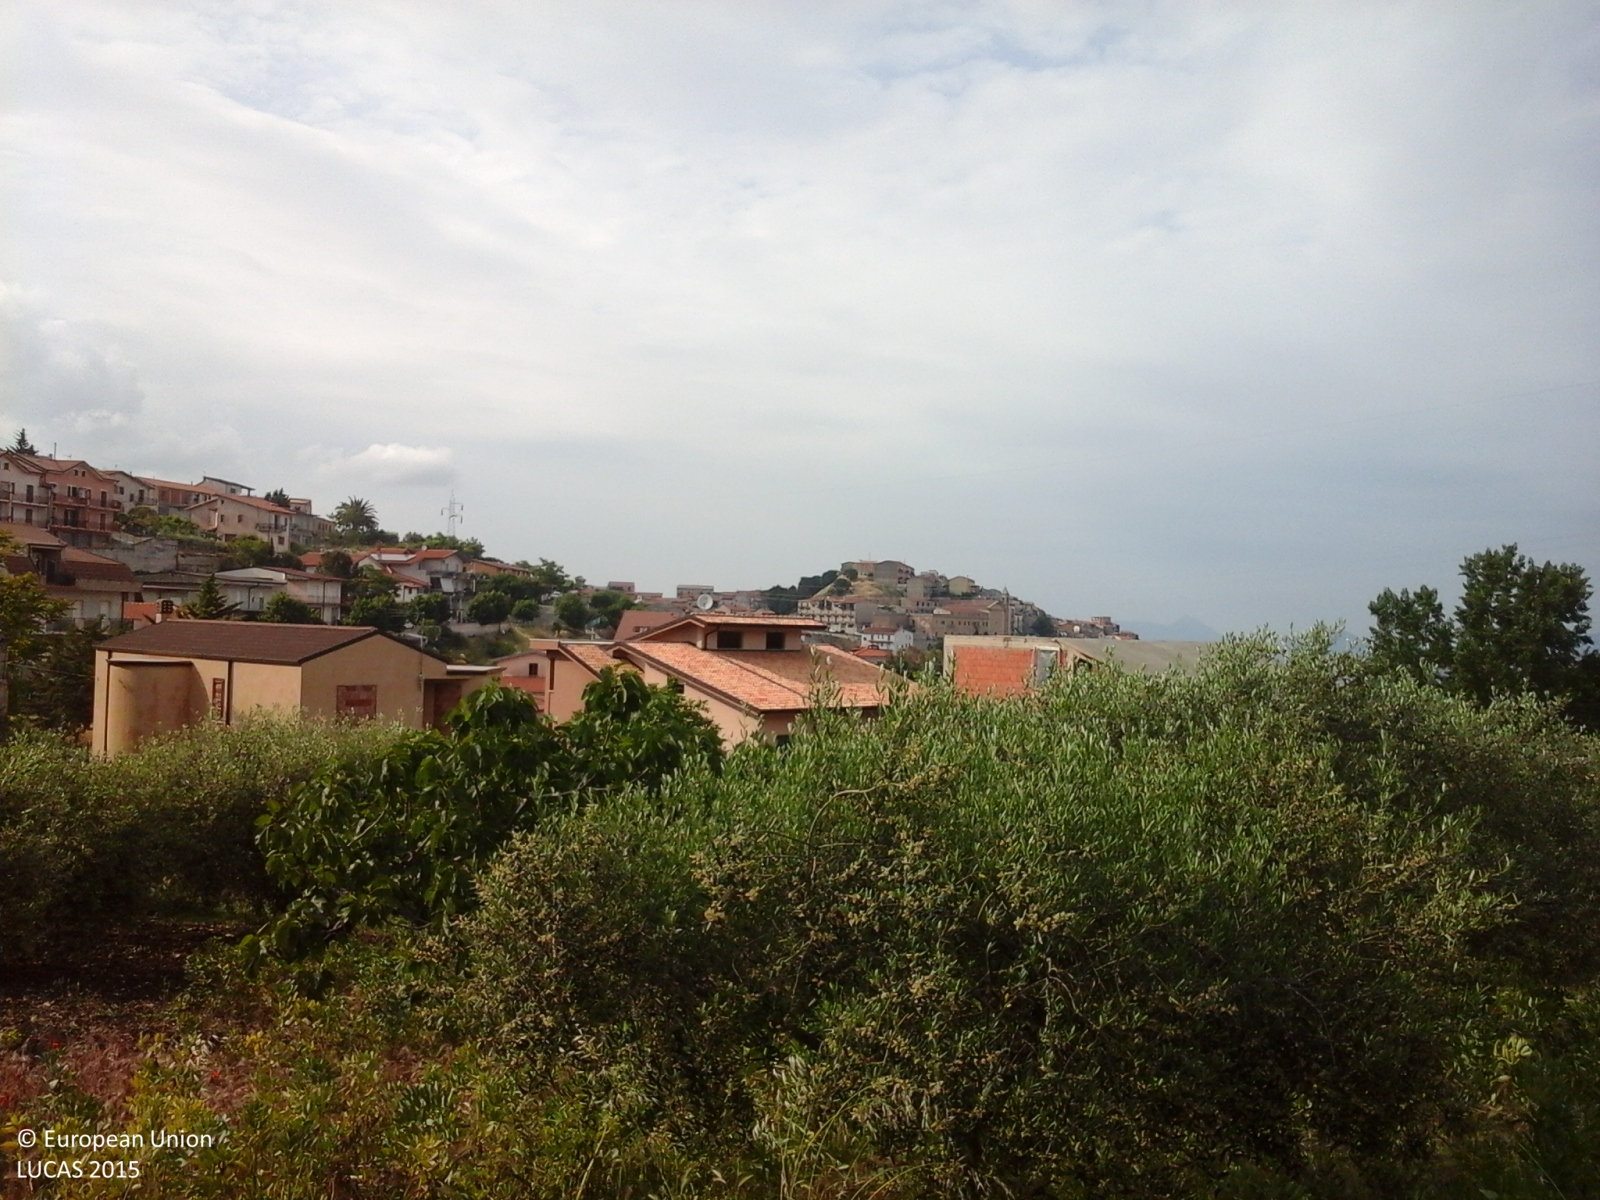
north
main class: Cropland
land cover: Olive groves
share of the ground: 50 - 75 %
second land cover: Other fresh vegetables
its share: > 75 %
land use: Agriculture (excluding fallow land and kitchen gardens)
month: June
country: IT
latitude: 37.6236
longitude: 13.6326
